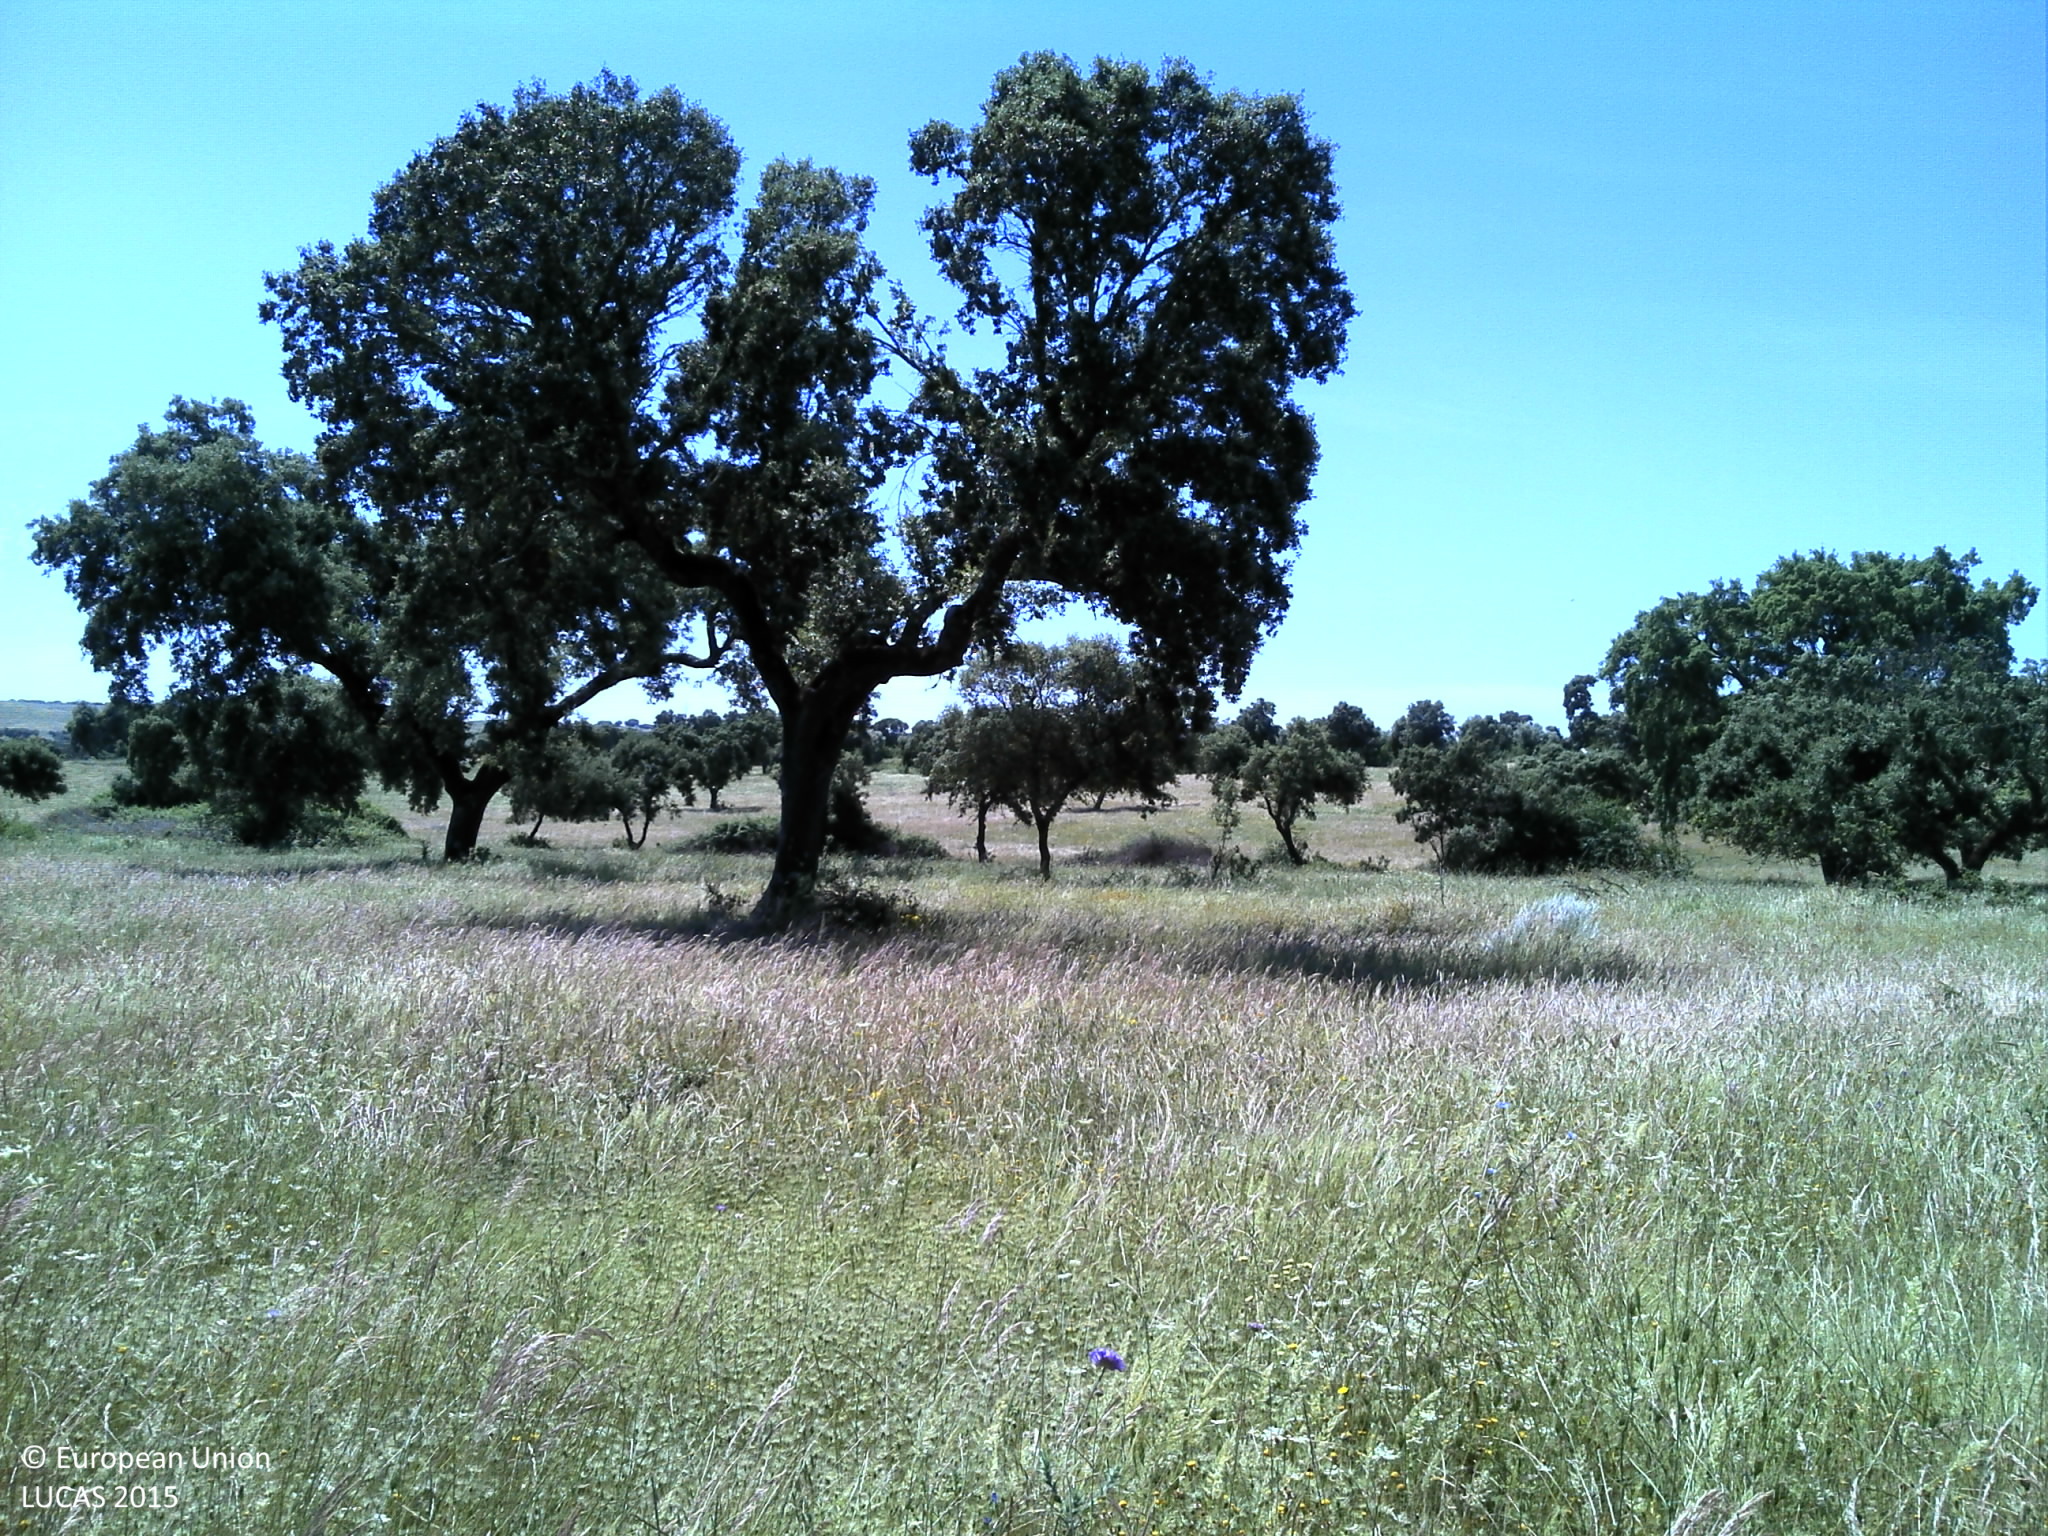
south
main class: Grassland
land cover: Grassland with sparse tree/shrub cover
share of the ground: > 75 %
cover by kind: herbaceous plants 90 %, broadleaved forest trees 5 %, unconsolidated bare surface 5 %
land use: Agriculture (excluding fallow land and kitchen gardens)
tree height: > 5 m
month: May
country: PT
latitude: 39.1499
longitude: -7.8571
